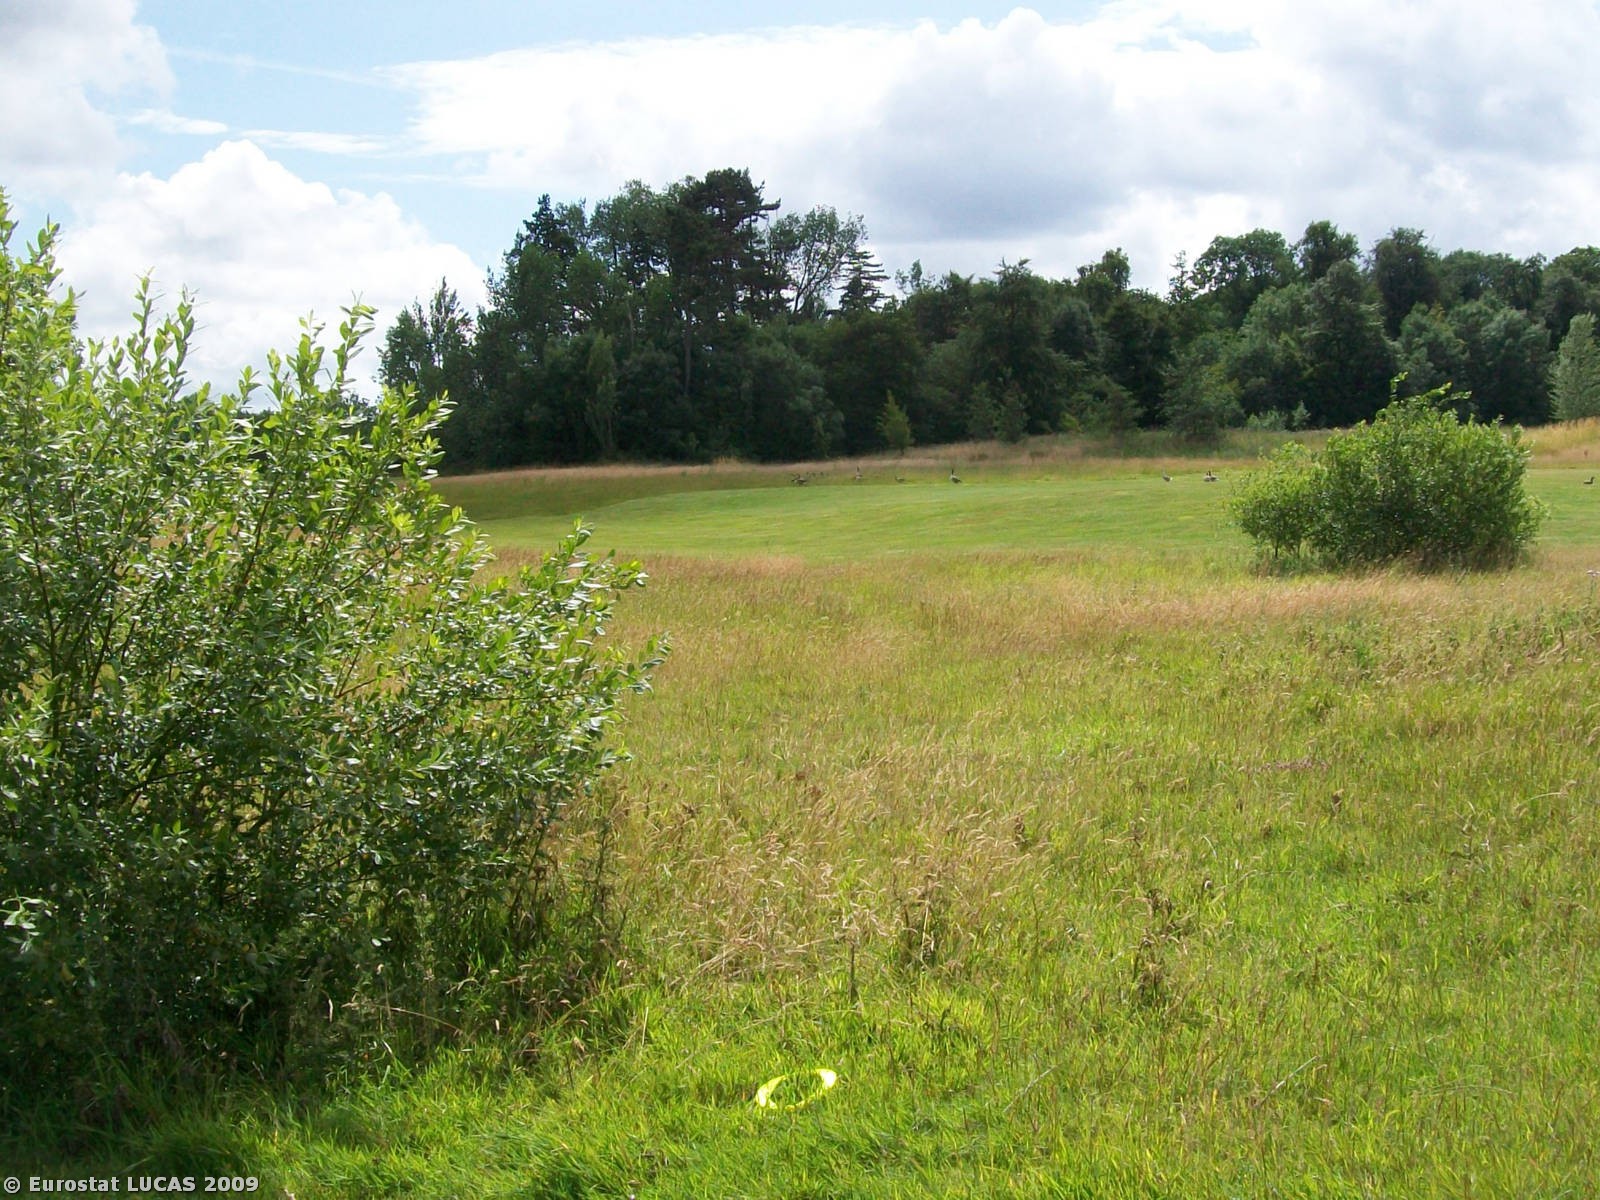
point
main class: Grassland
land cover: Grassland with sparse tree/shrub cover
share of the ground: > 75 %
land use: Sport
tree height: > 5 m
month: July
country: GB
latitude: 51.3752
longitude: -2.2594
